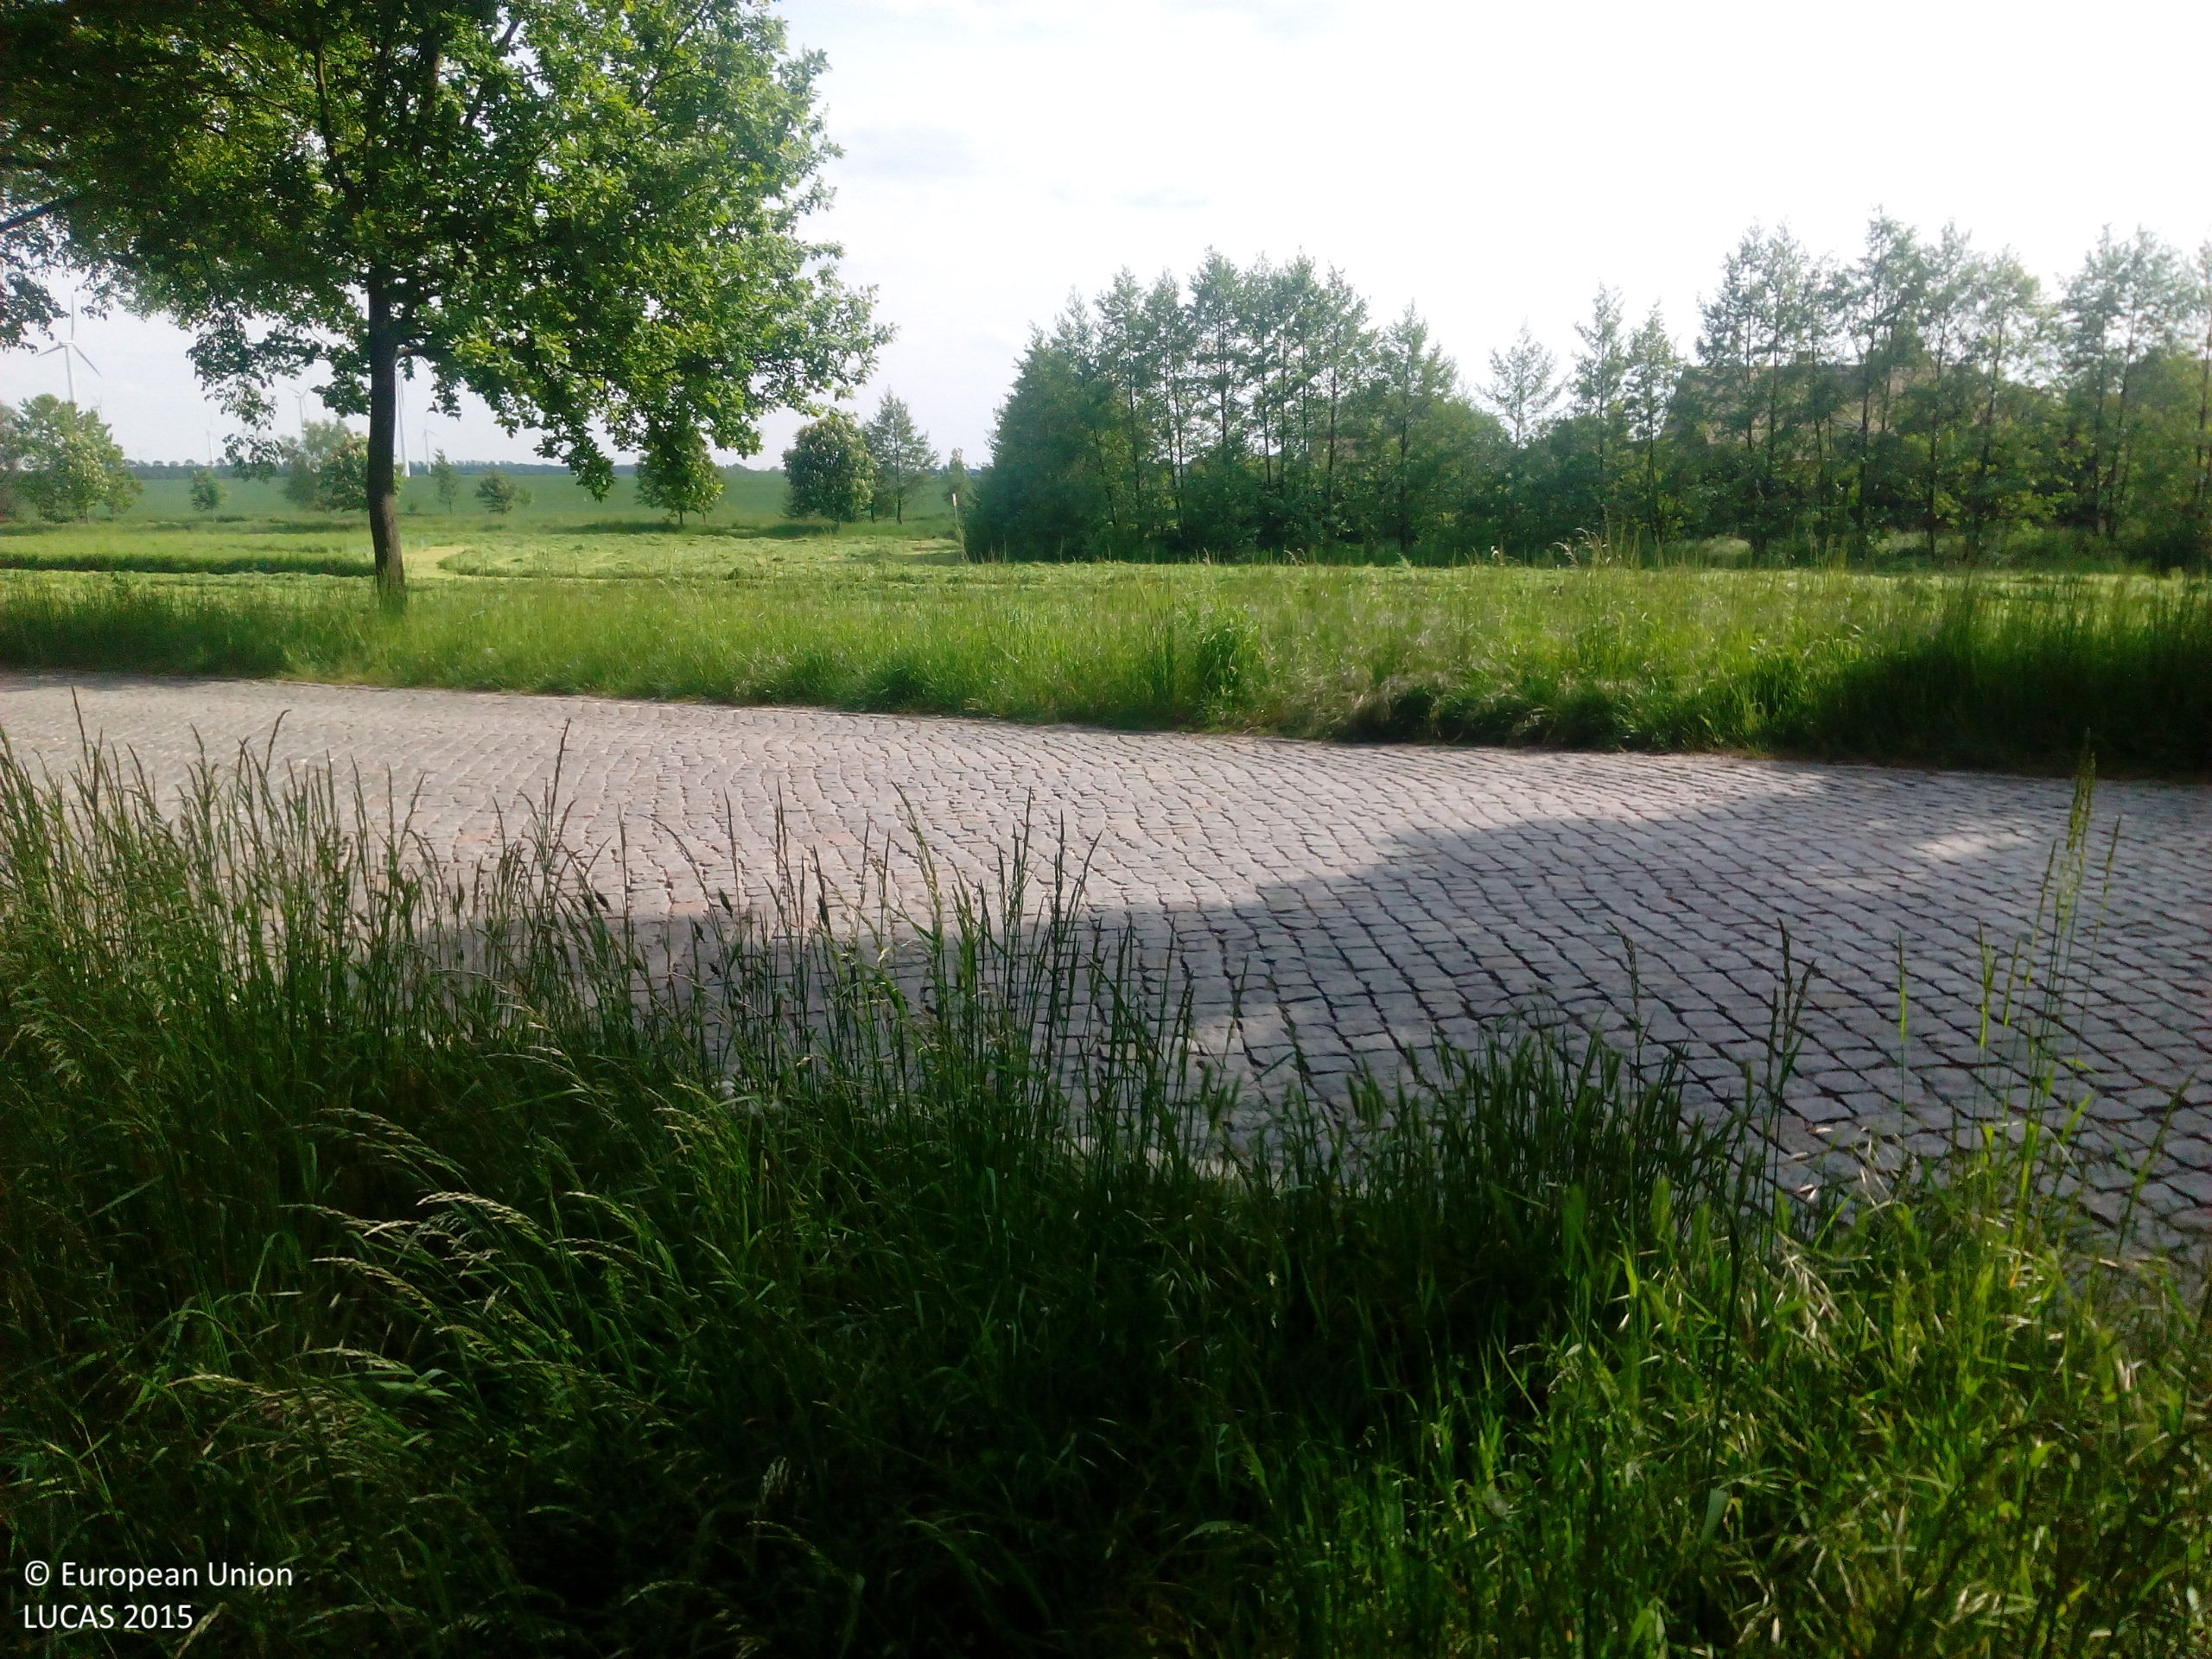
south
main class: Woodland
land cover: Broadleaved woodland
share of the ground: > 75 %
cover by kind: broadleaved forest trees 90 %, herbaceous plants 10 %
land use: Agriculture (excluding fallow land and kitchen gardens)
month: May
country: DE
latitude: 51.4726
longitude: 12.3752
